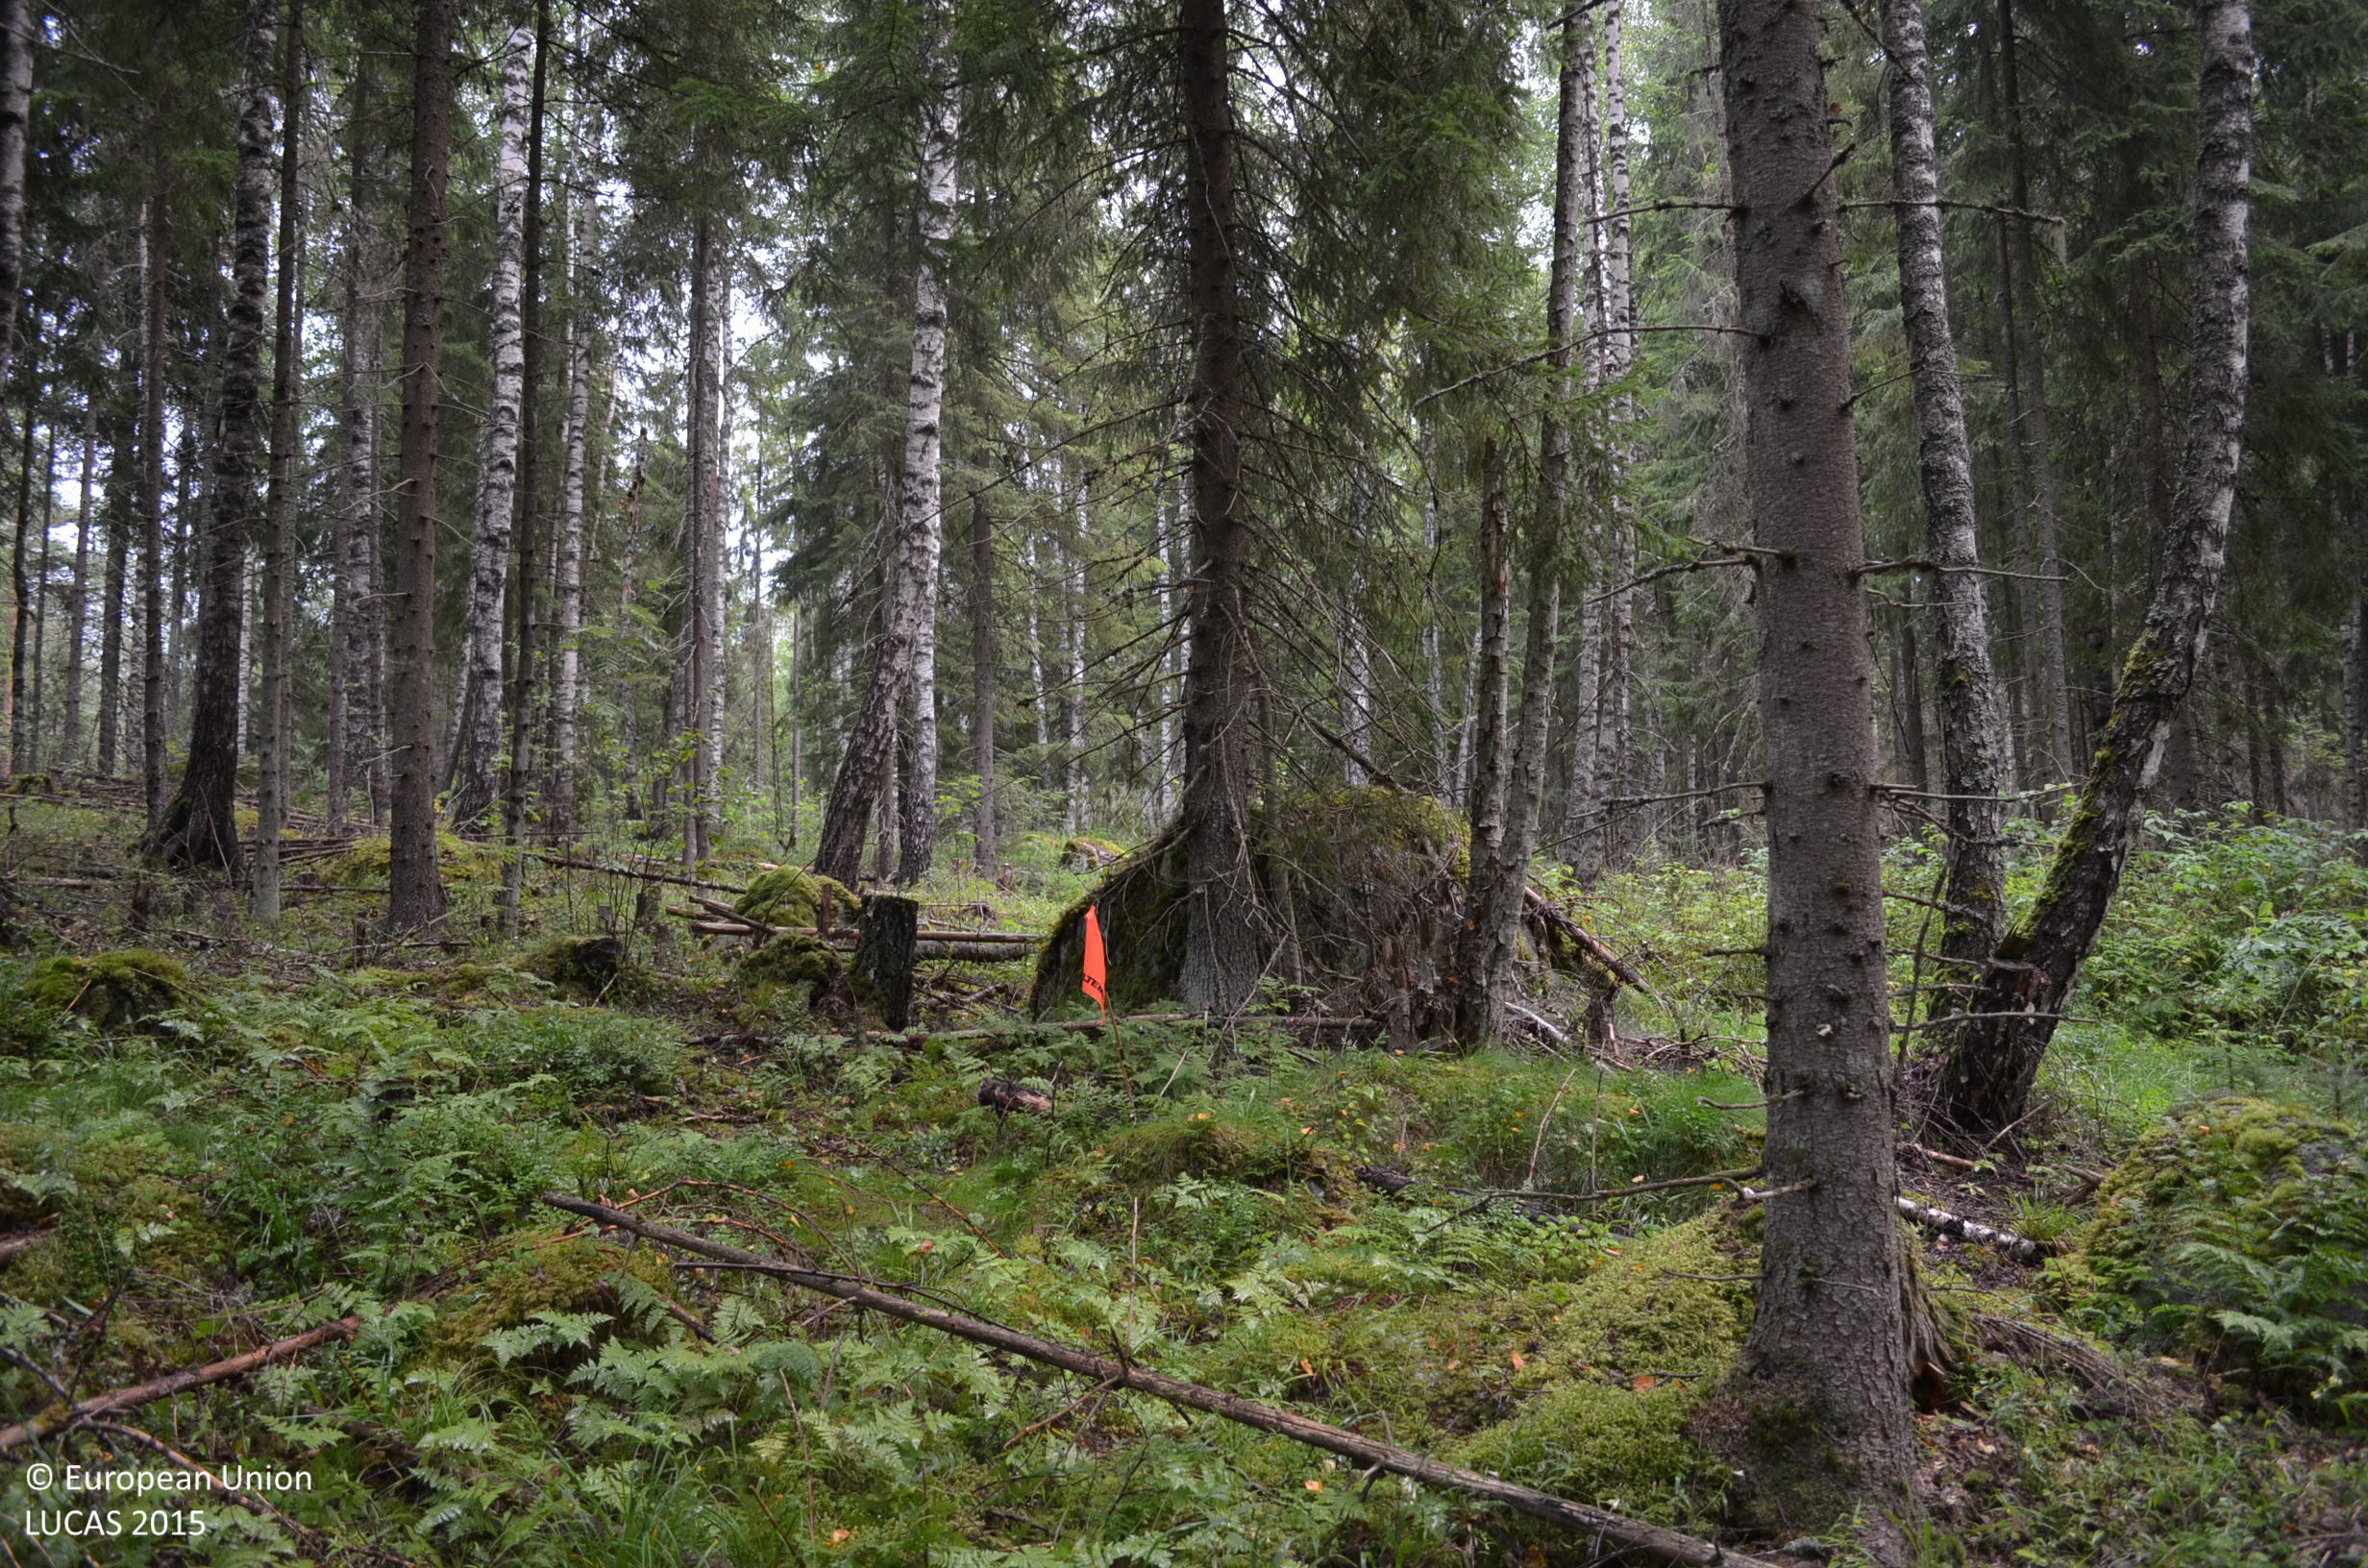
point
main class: Woodland
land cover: Spruce dominated mixed woodland
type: boreal forest
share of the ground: 50 - 75 %
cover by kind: broadleaved forest trees 40 %, coniferous forest trees 30 %, herbaceous plants 25 %, shrubs 5 %
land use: Forestry
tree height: > 5 m
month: August
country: FI
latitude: 61.5382
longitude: 23.1459
